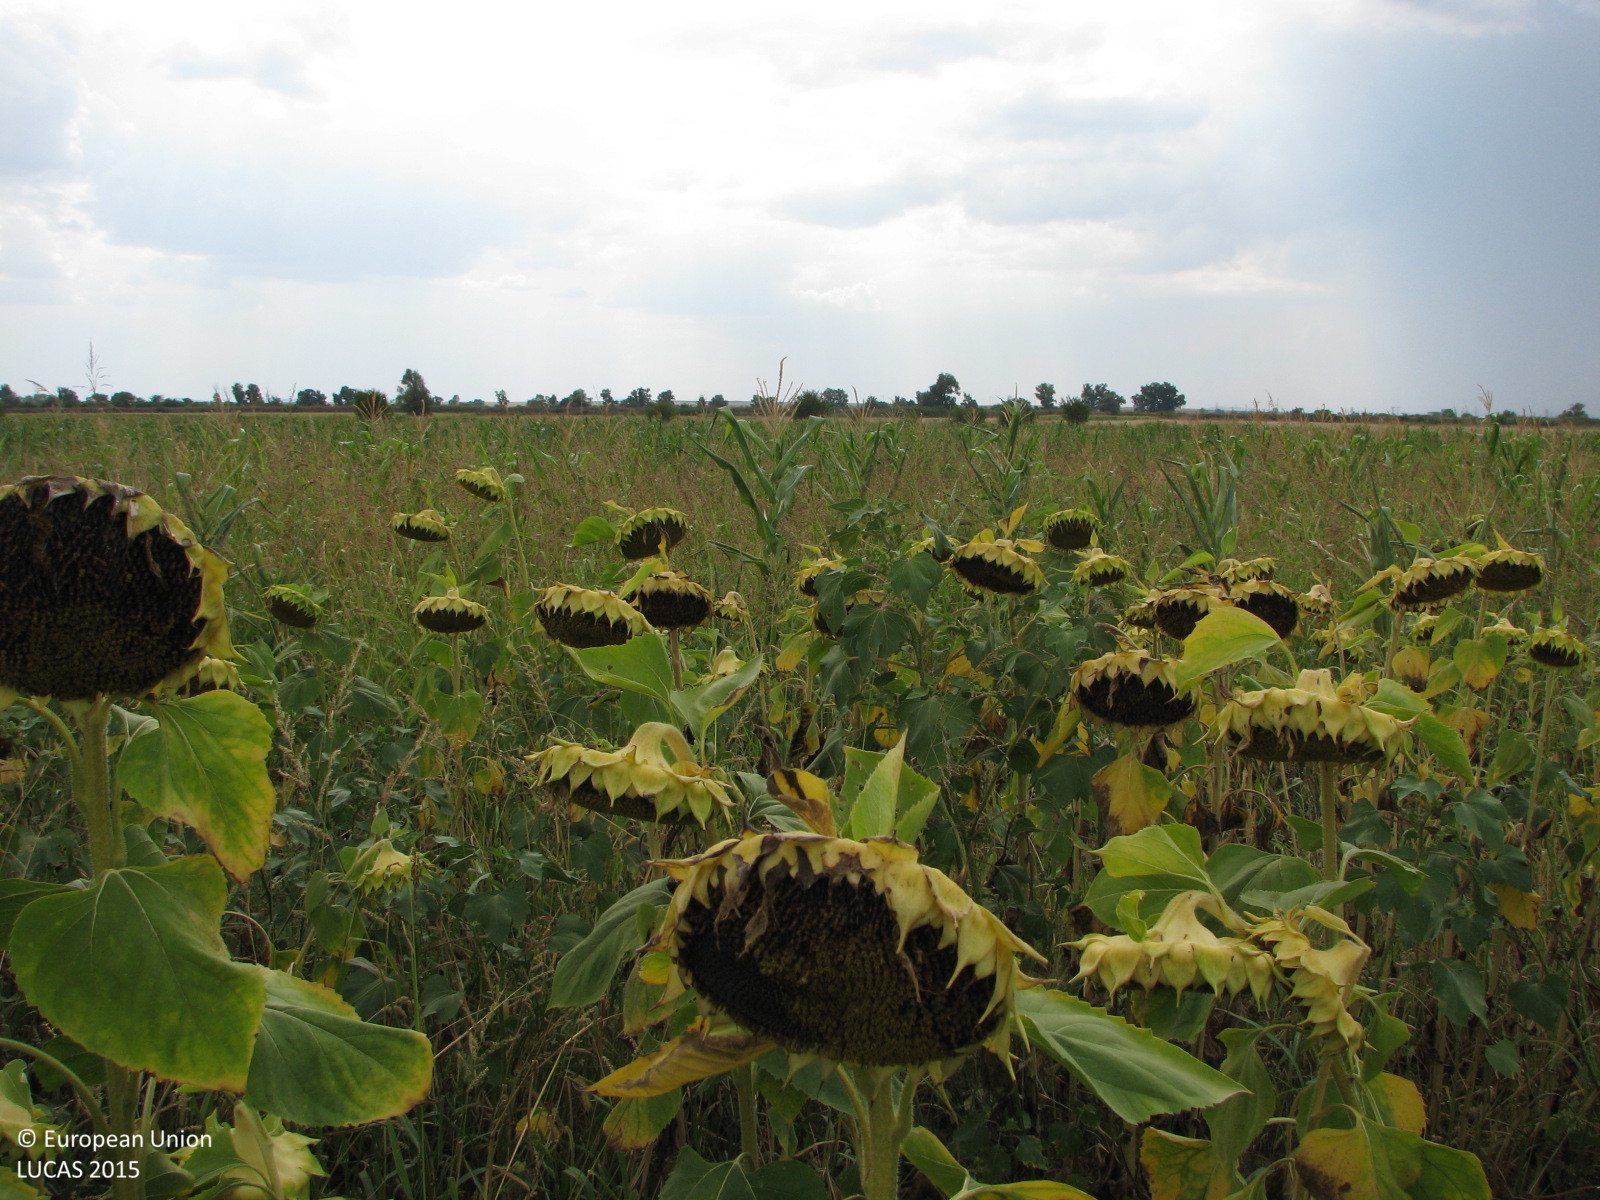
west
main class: Cropland
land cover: Sunflower
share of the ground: > 75 %
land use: Agriculture (excluding fallow land and kitchen gardens)
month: August
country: BG
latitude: 42.4457
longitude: 26.5175
